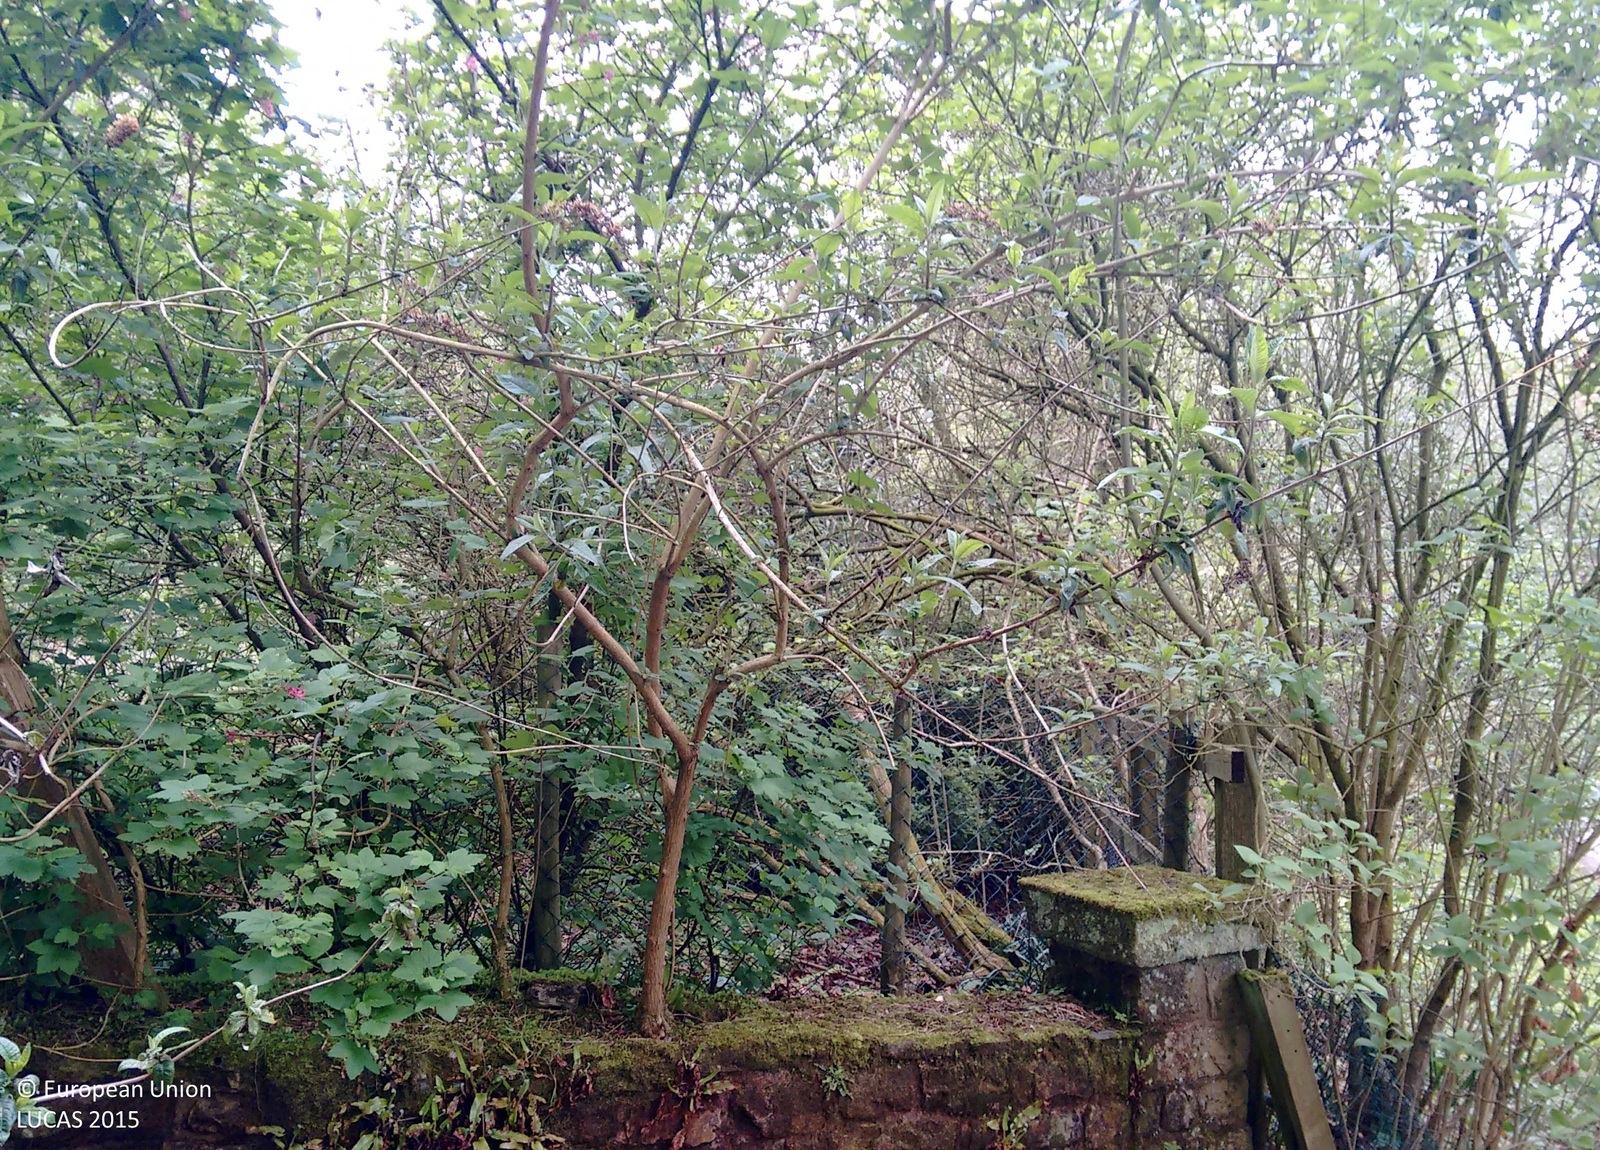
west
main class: Woodland
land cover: Other mixed woodland
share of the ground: > 75 %
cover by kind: coniferous forest trees 50 %, broadleaved forest trees 50 %
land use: Forestry
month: May
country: GB
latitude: 54.0736
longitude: -2.7380
